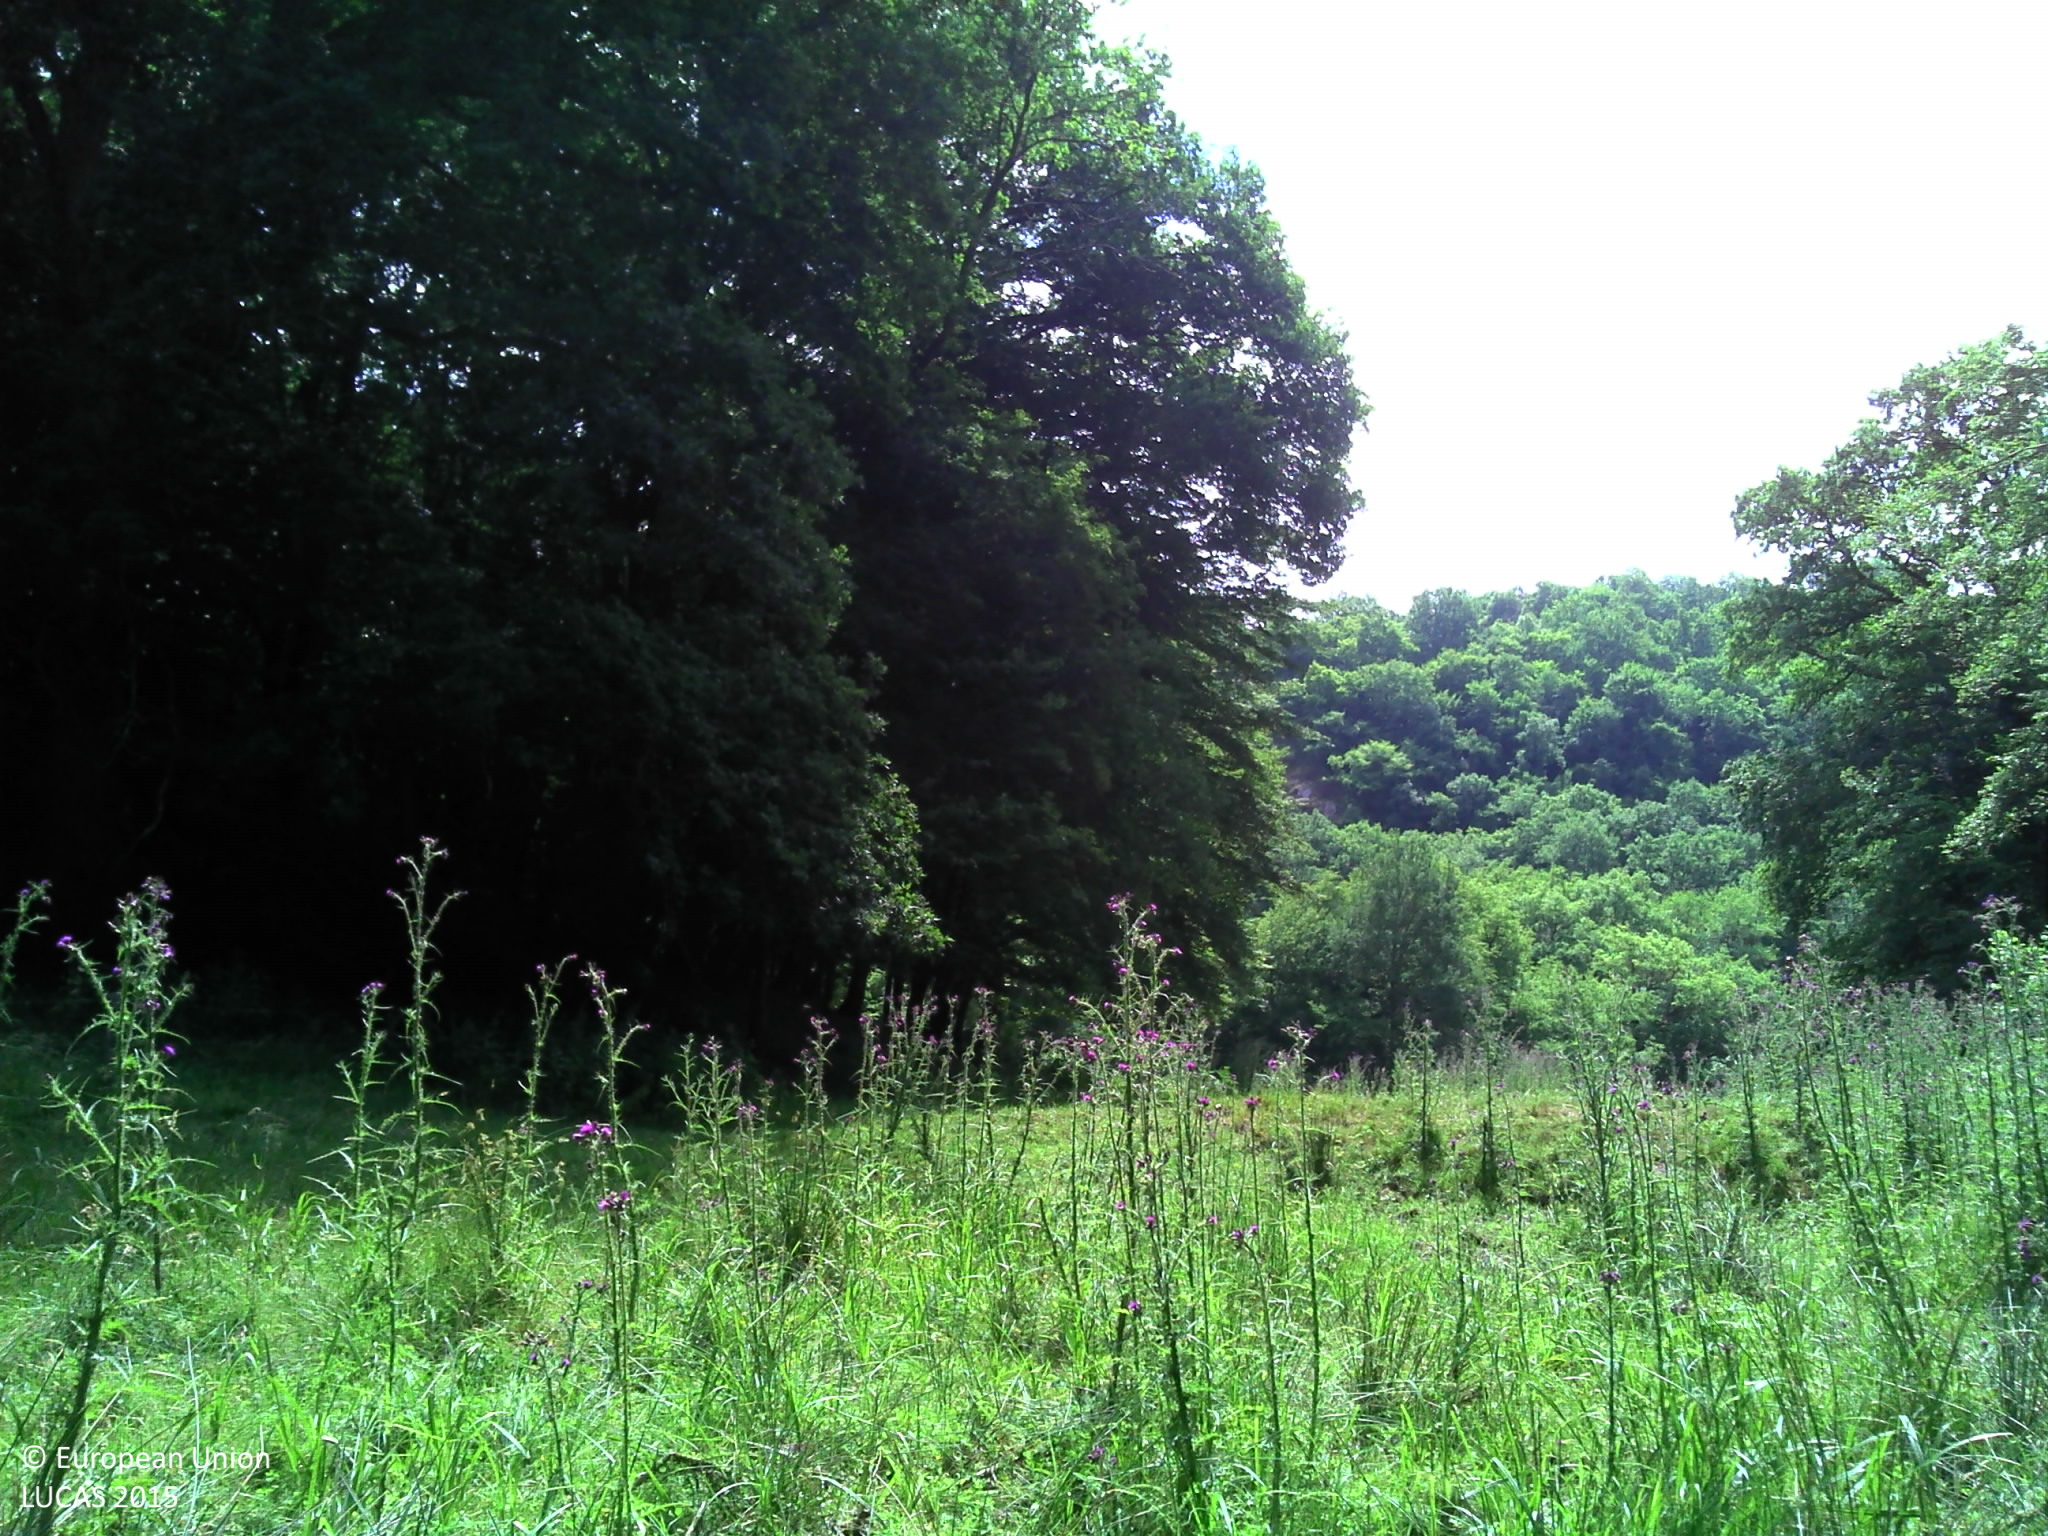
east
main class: Woodland
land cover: Broadleaved woodland
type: mesophytic deciduous forest
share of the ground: > 75 %
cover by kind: broadleaved forest trees 90 %, shrubs 10 %
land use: Forestry
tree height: > 5 m
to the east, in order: Broadleaved woodland; Grassland without tree/shrub cover; Broadleaved woodland; Fences; Broadleaved woodland; Fences; Broadleaved woodland; Fences; Broadleaved woodland; Inland fresh running water; Broadleaved woodland; Shrubland without tree cover; Broadleaved woodland
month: June
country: FR
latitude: 46.2846
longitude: 3.0021
